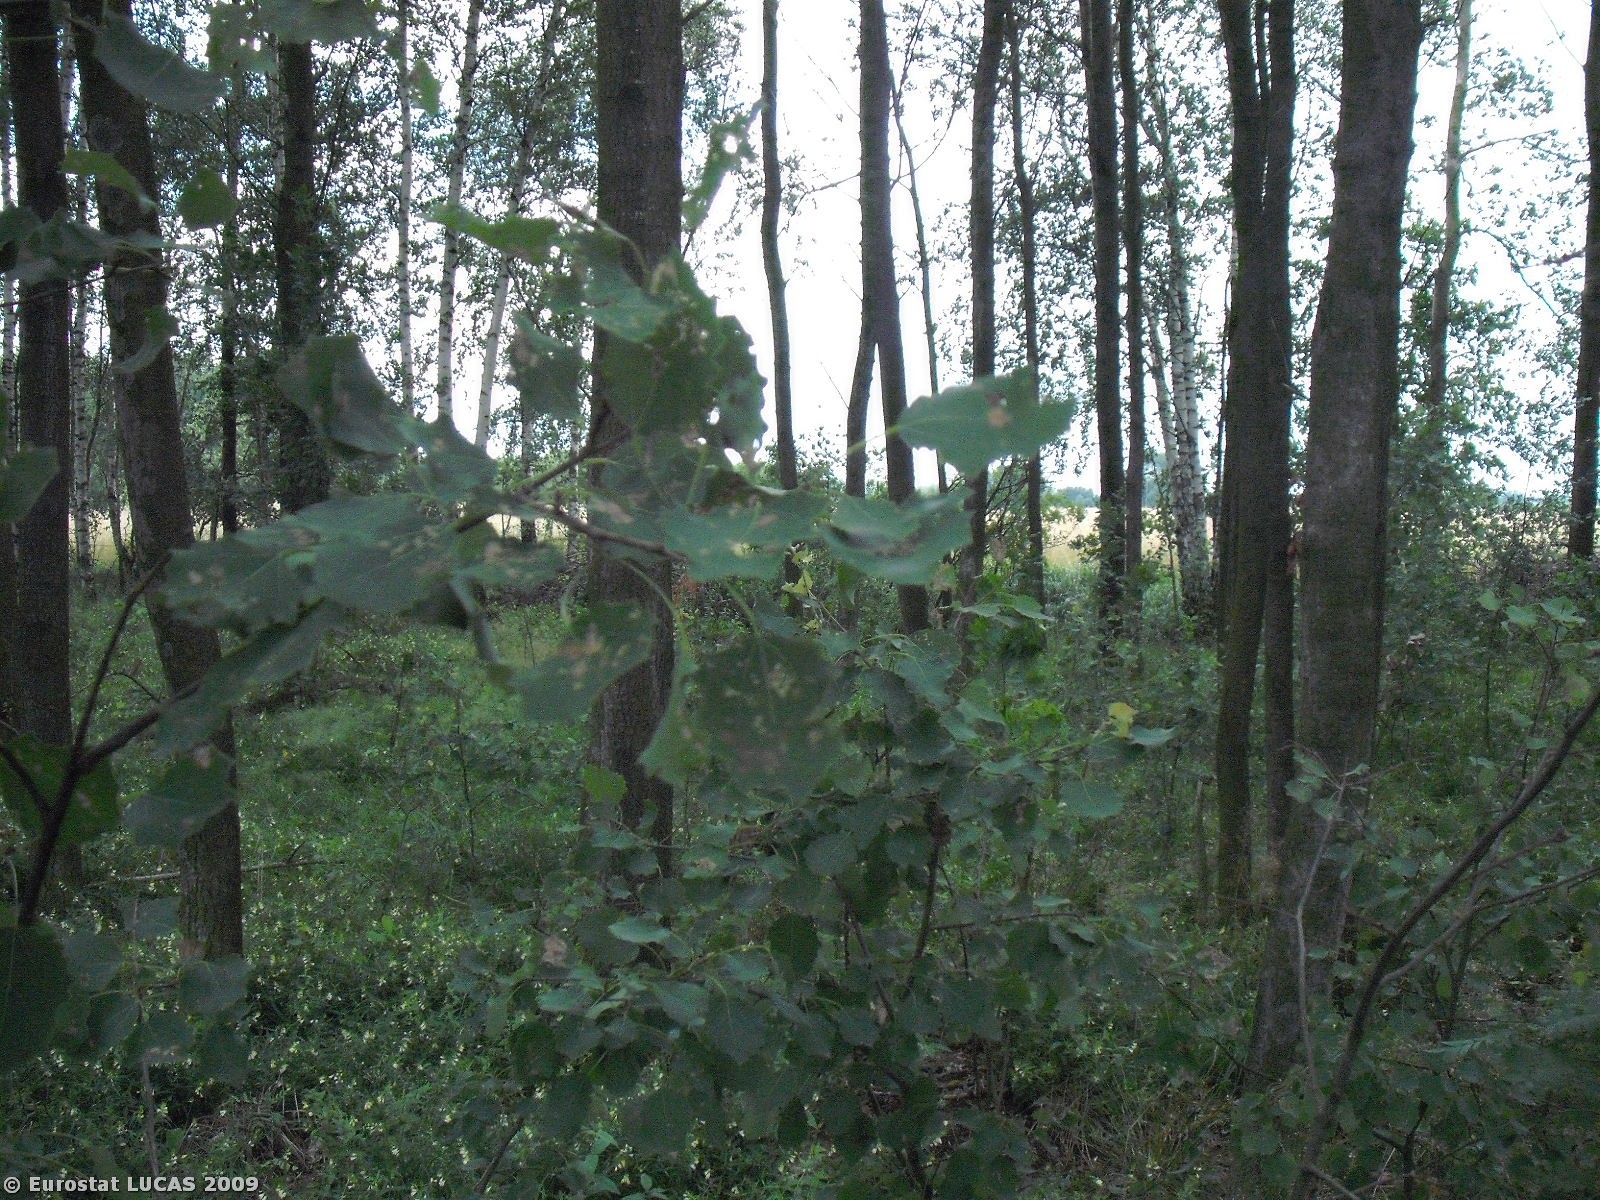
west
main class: Woodland
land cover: Broadleaved woodland
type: mesophytic deciduous forest
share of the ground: > 75 %
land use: Forestry
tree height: > 5 m
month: July
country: PL
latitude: 51.4973
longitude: 20.6564
